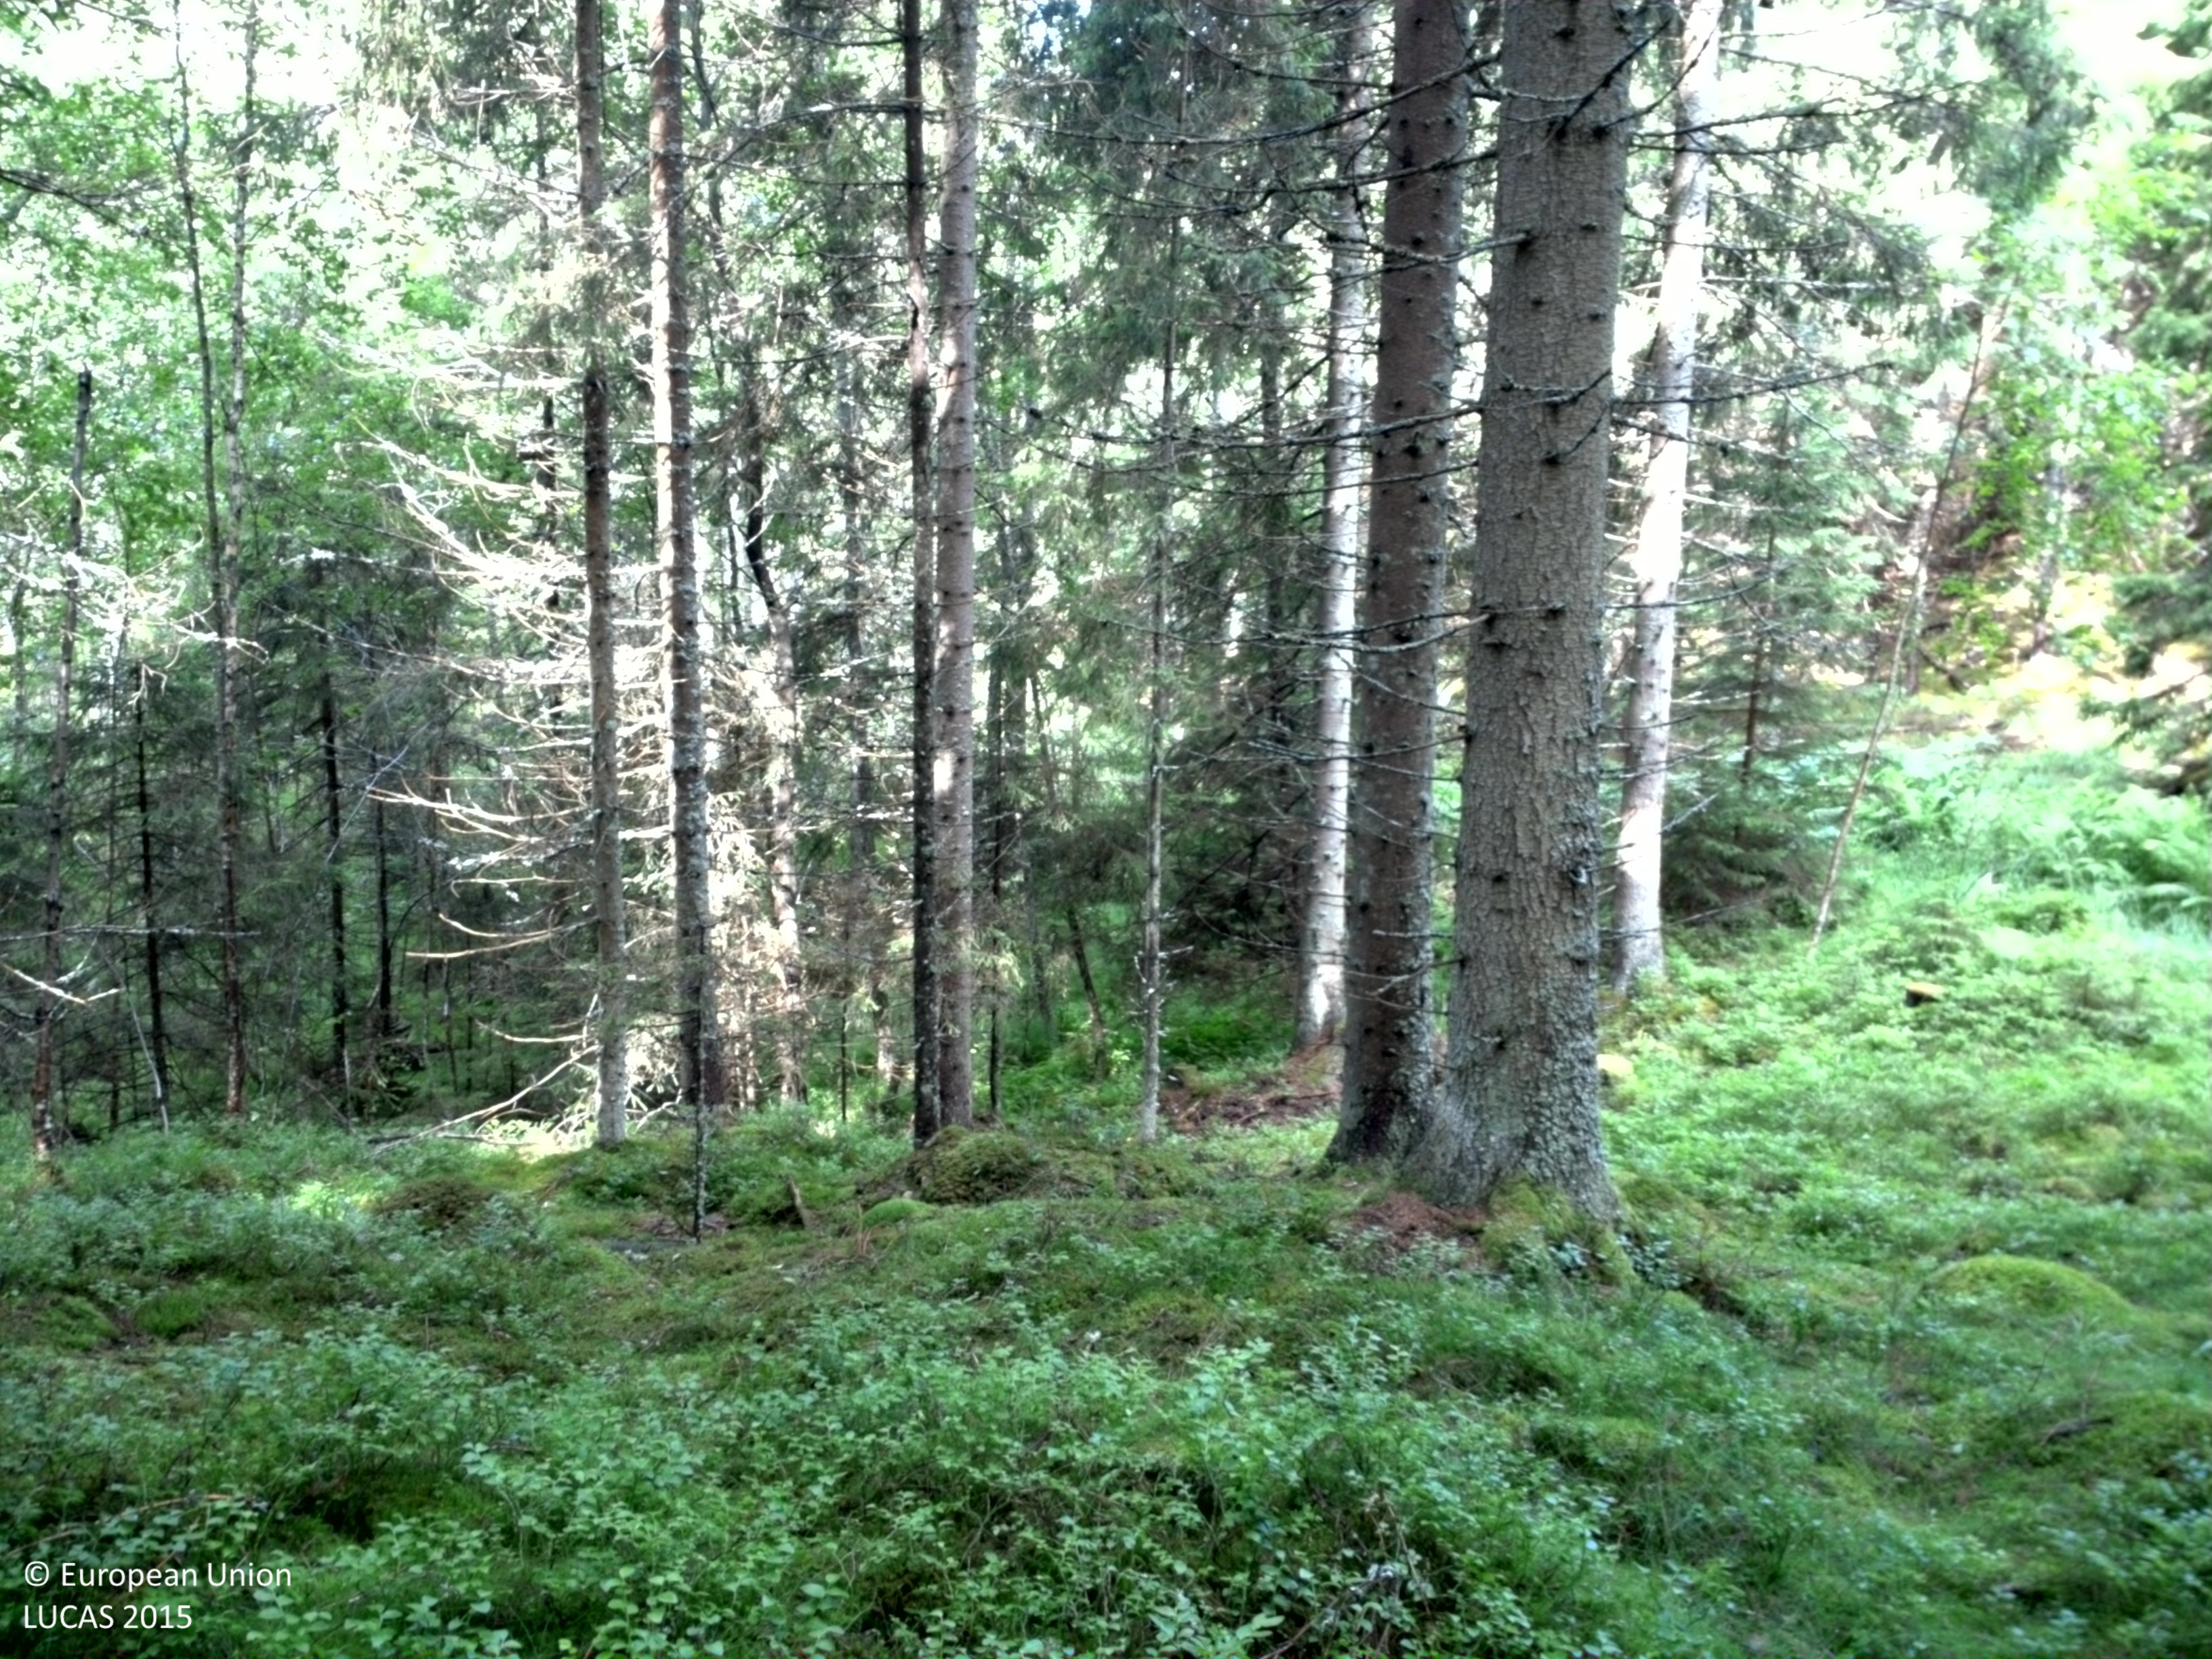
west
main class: Woodland
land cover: Spruce dominated coniferous woodland
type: boreal forest
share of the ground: 25 - 50 %
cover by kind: coniferous forest trees 40 %, lichens and mosses 35 %, herbaceous plants 25 %
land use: Forestry
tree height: > 5 m
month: July
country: SE
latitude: 58.7460
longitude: 15.7481
